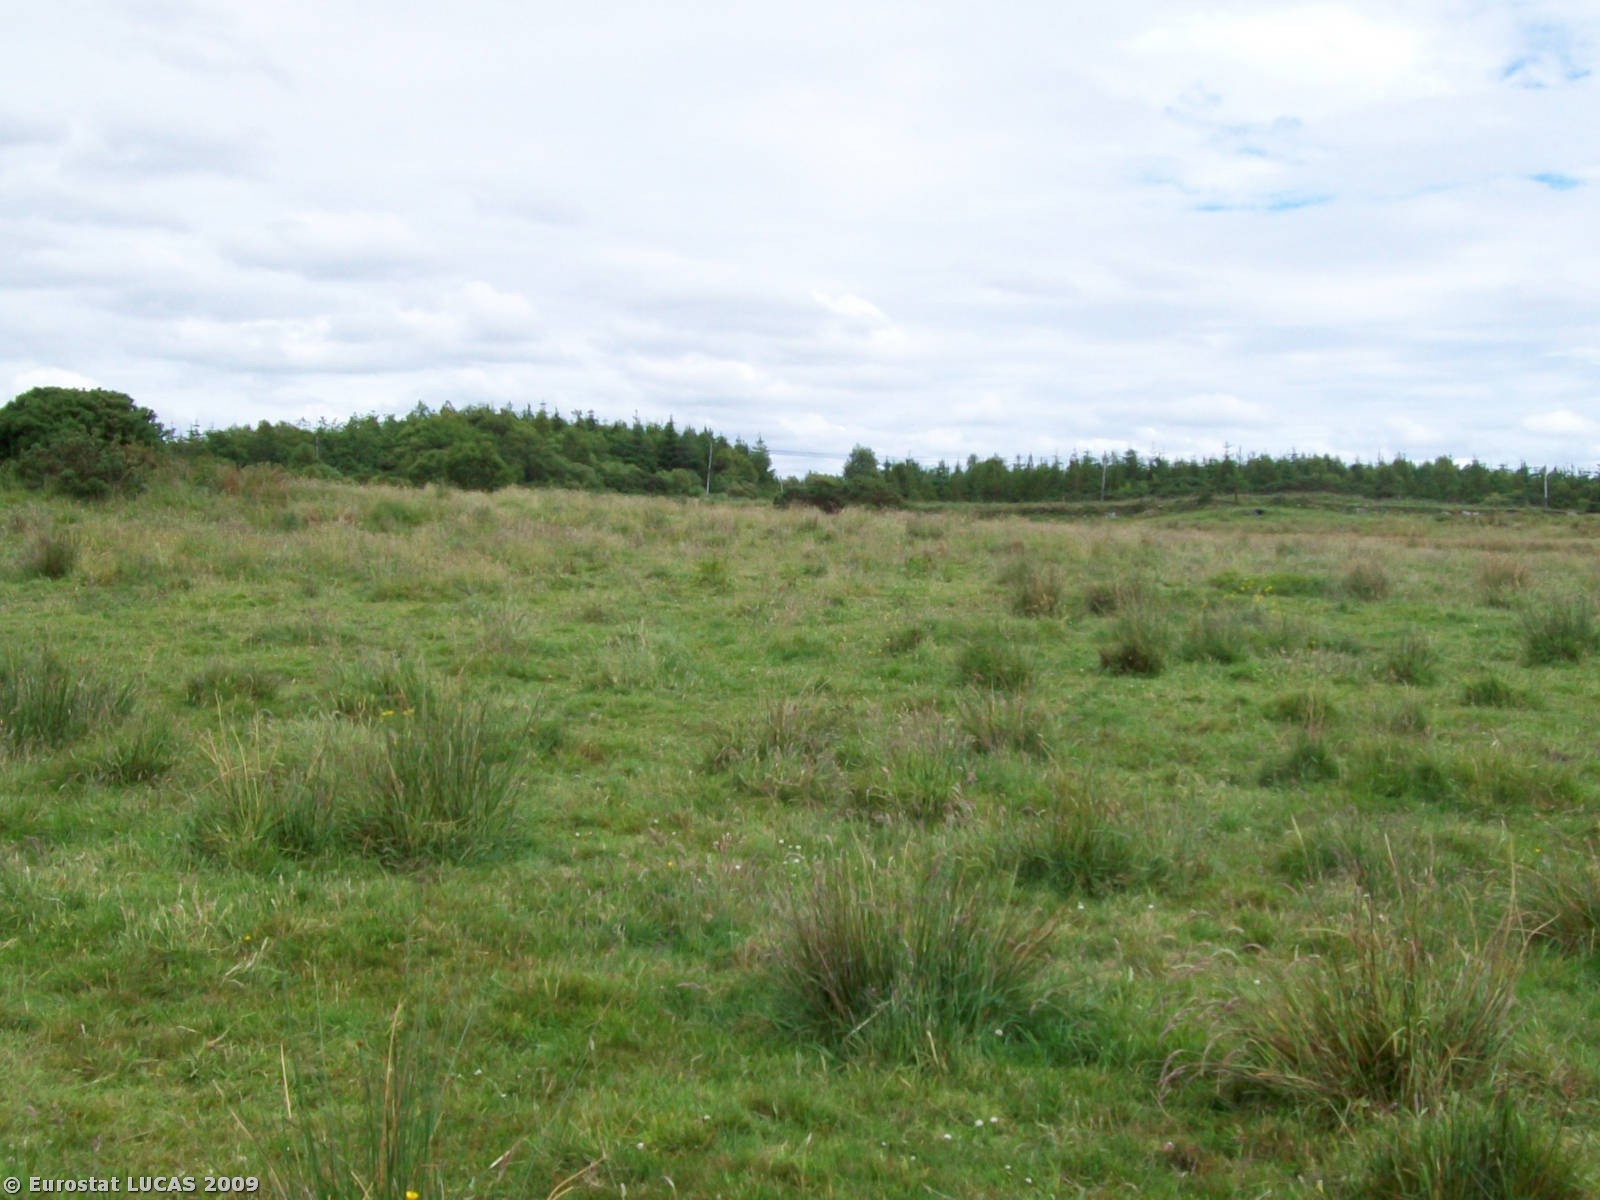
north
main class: Grassland
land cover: Grassland without tree/shrub cover
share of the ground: > 75 %
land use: Agriculture (excluding fallow land and kitchen gardens)
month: June
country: IE
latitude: 53.8153
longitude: -9.0316
